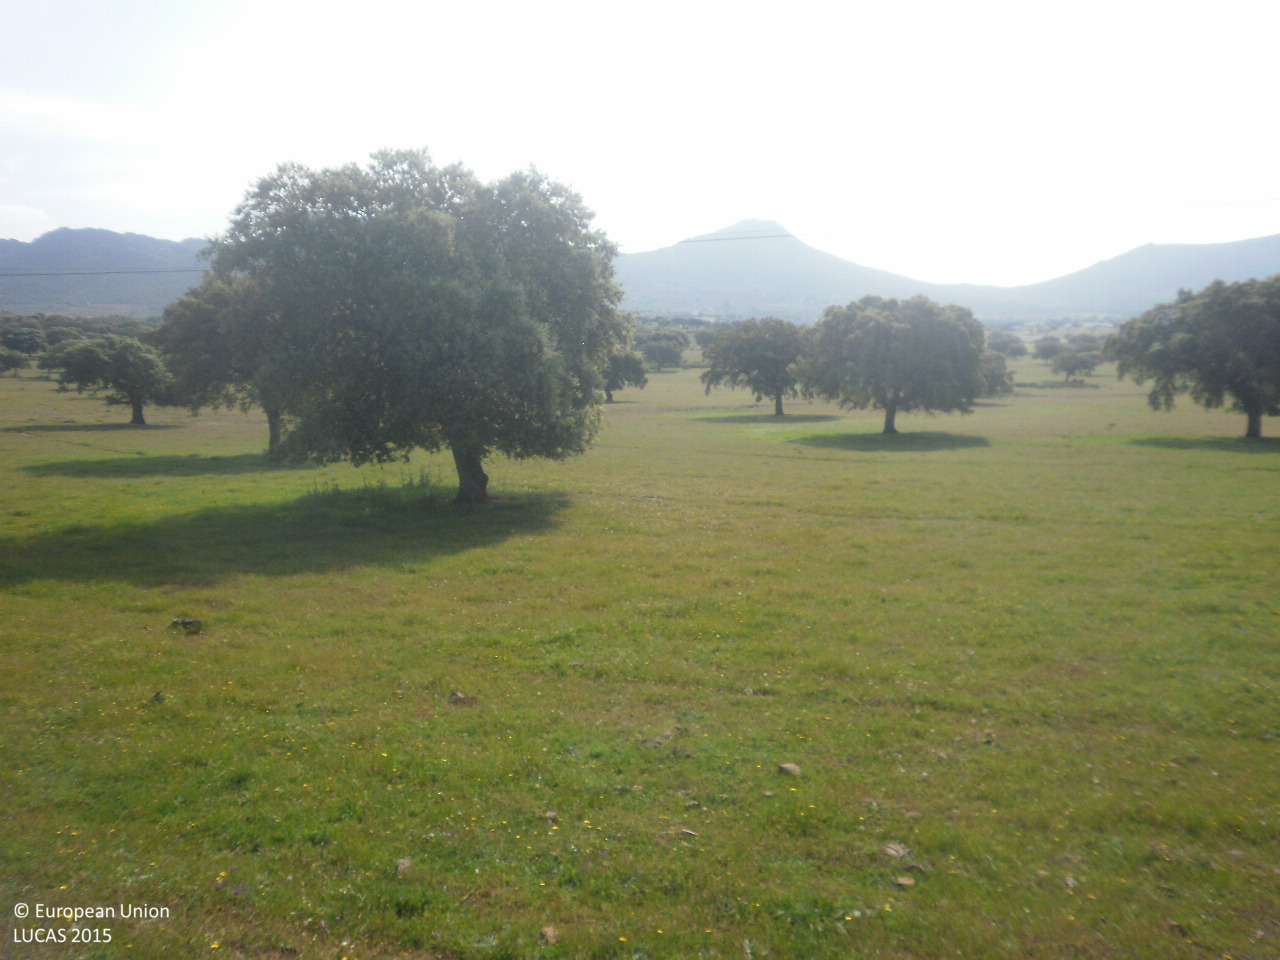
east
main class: Grassland
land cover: Grassland with sparse tree/shrub cover
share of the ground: > 75 %
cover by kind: herbaceous plants 90 %, broadleaved forest trees 5 %, shrubs 5 %
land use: Agriculture (excluding fallow land and kitchen gardens)
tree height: > 5 m
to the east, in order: Grassland with sparse tree/shrub cover
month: April
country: ES
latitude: 38.7641
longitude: -5.1916
